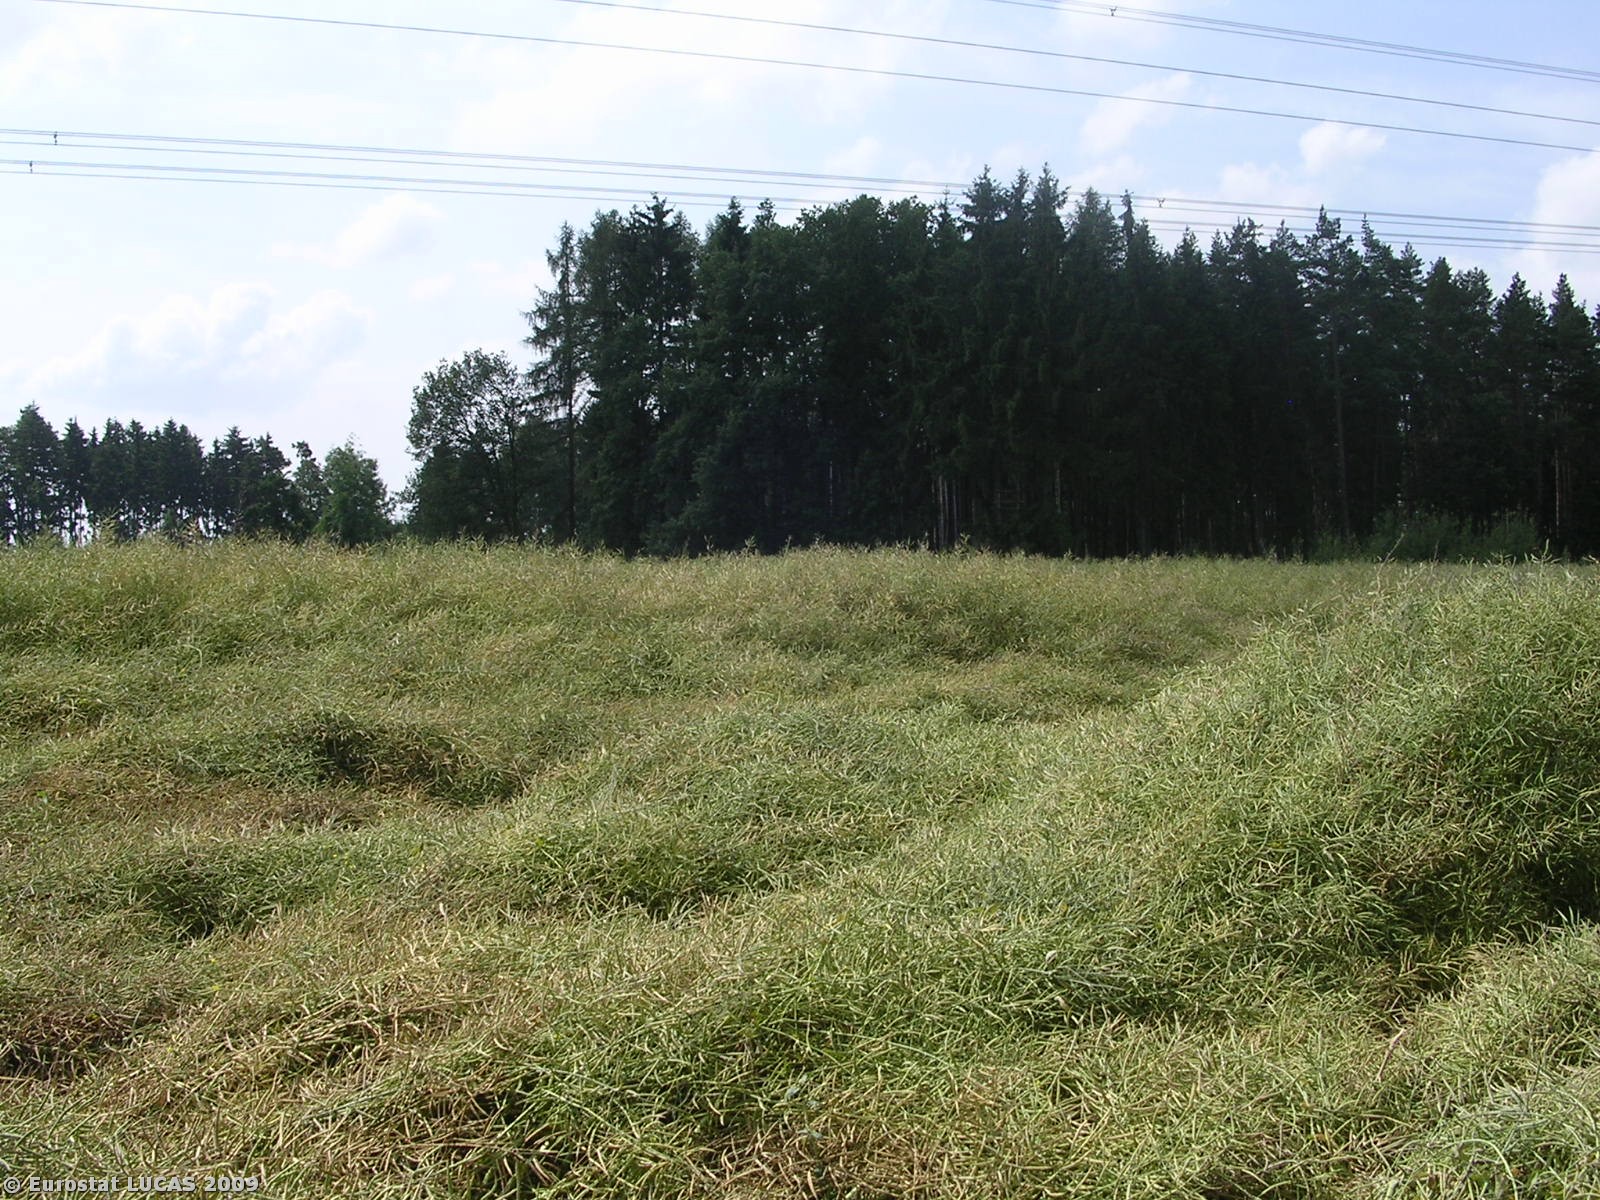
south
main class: Cropland
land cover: Rape and turnip rape
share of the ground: > 75 %
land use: Agriculture (excluding fallow land and kitchen gardens)
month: July
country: CZ
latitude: 50.6130
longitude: 15.0482
